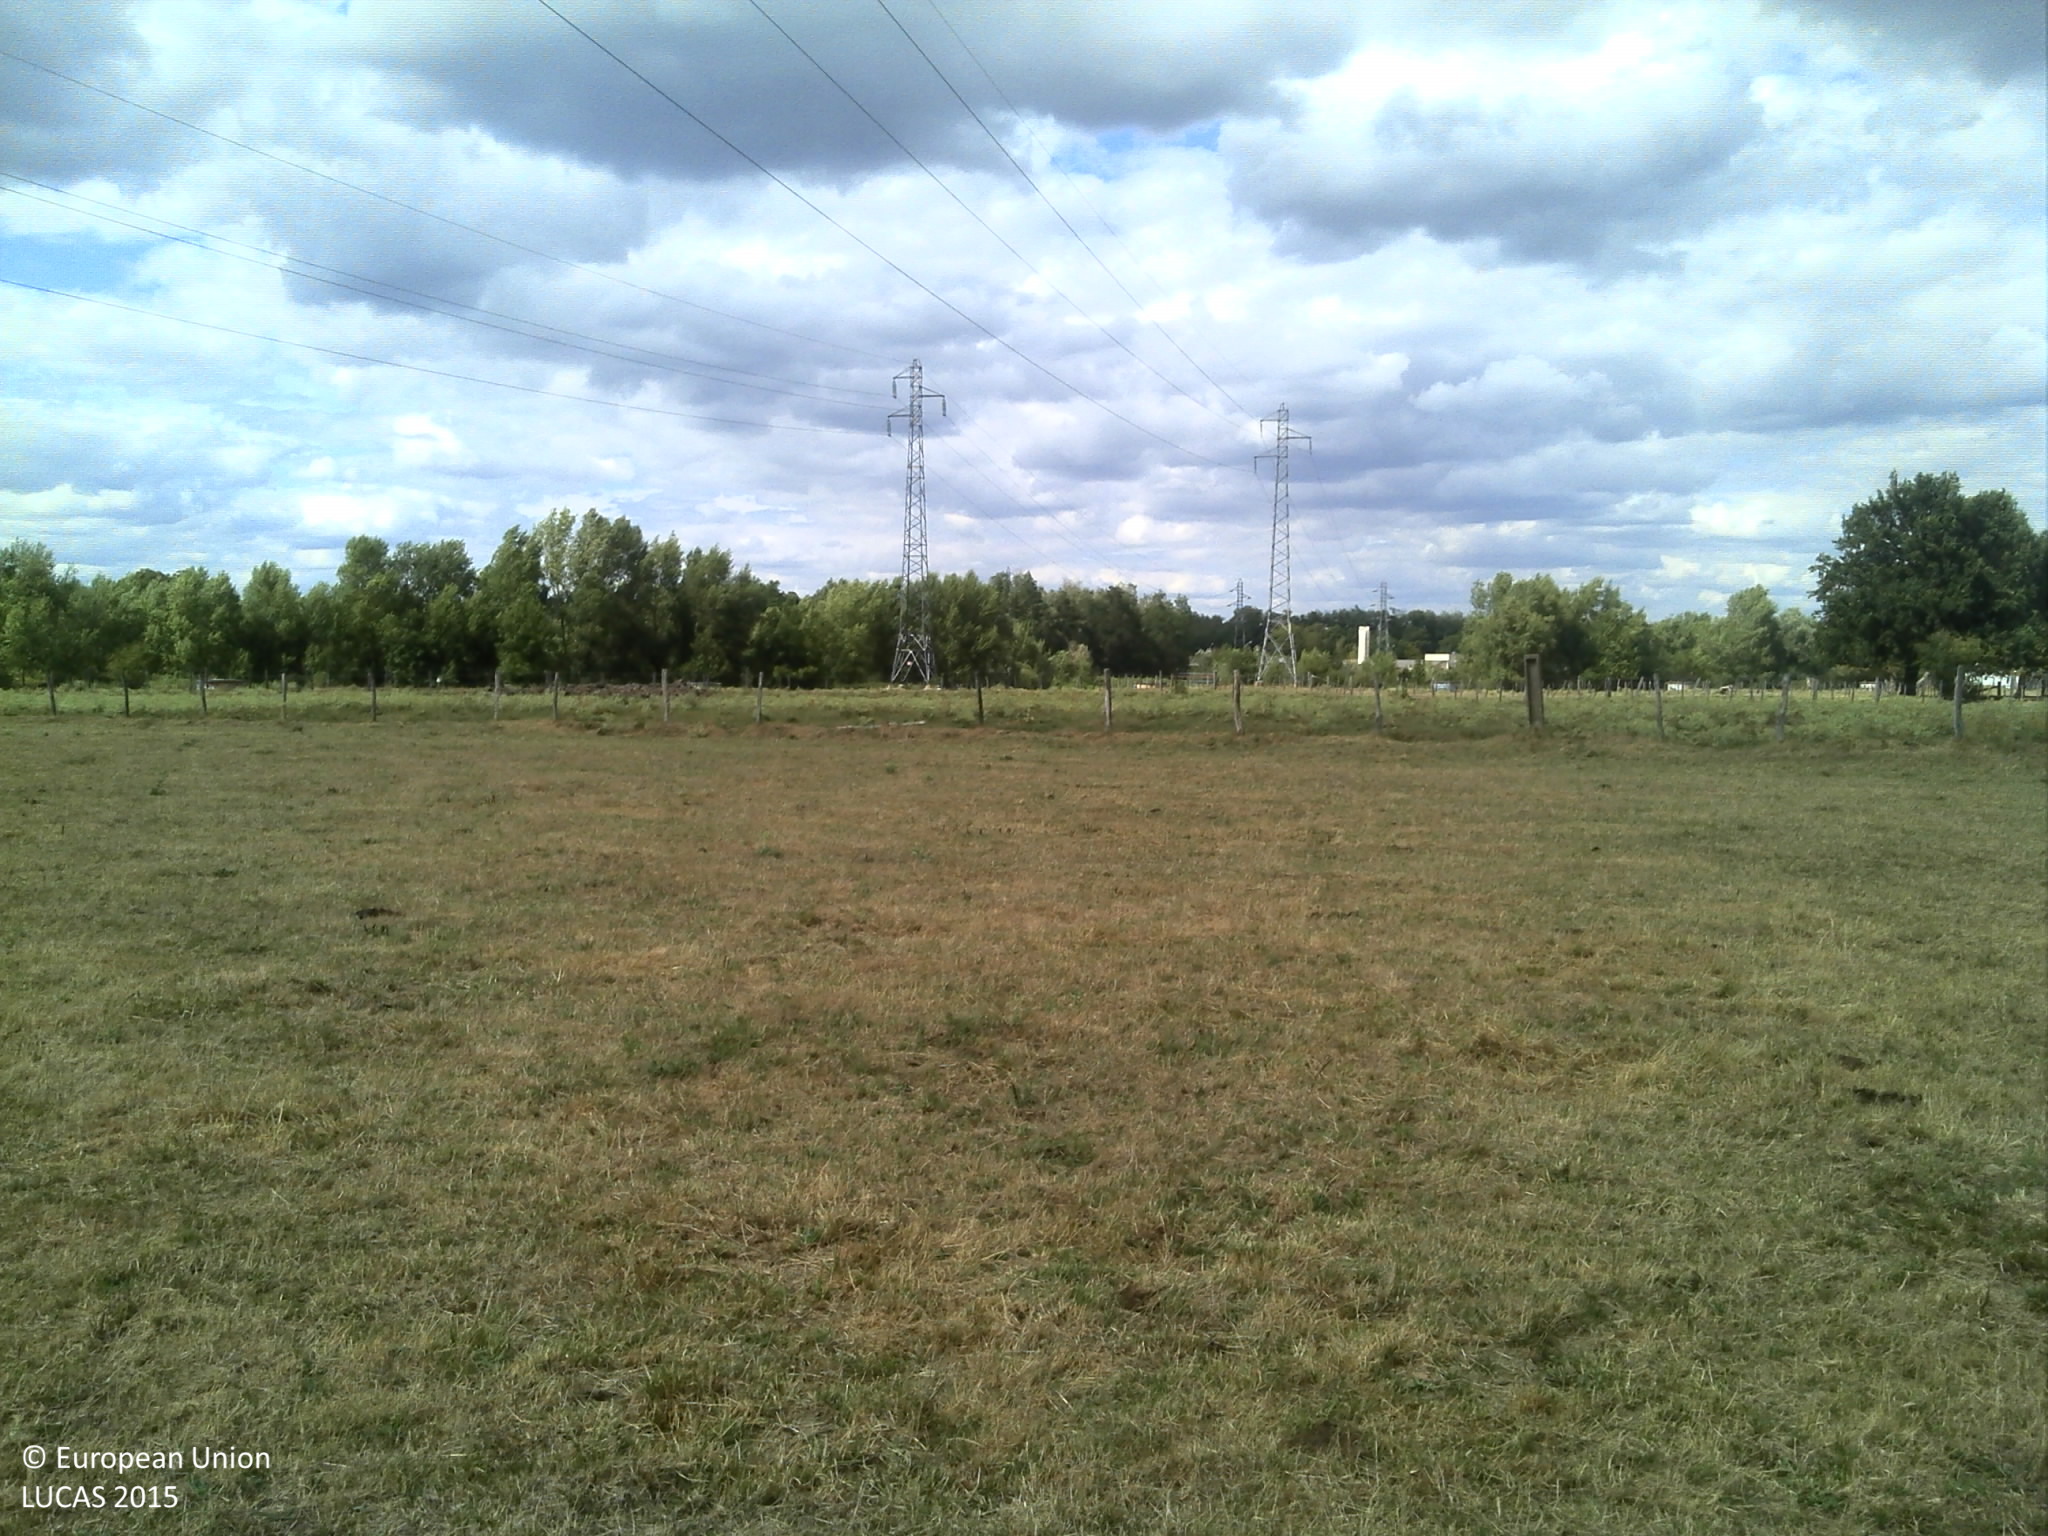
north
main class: Grassland
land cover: Grassland without tree/shrub cover
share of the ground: > 75 %
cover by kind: herbaceous plants 100 %
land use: Agriculture (excluding fallow land and kitchen gardens)
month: July
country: FR
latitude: 46.0436
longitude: 4.0960
